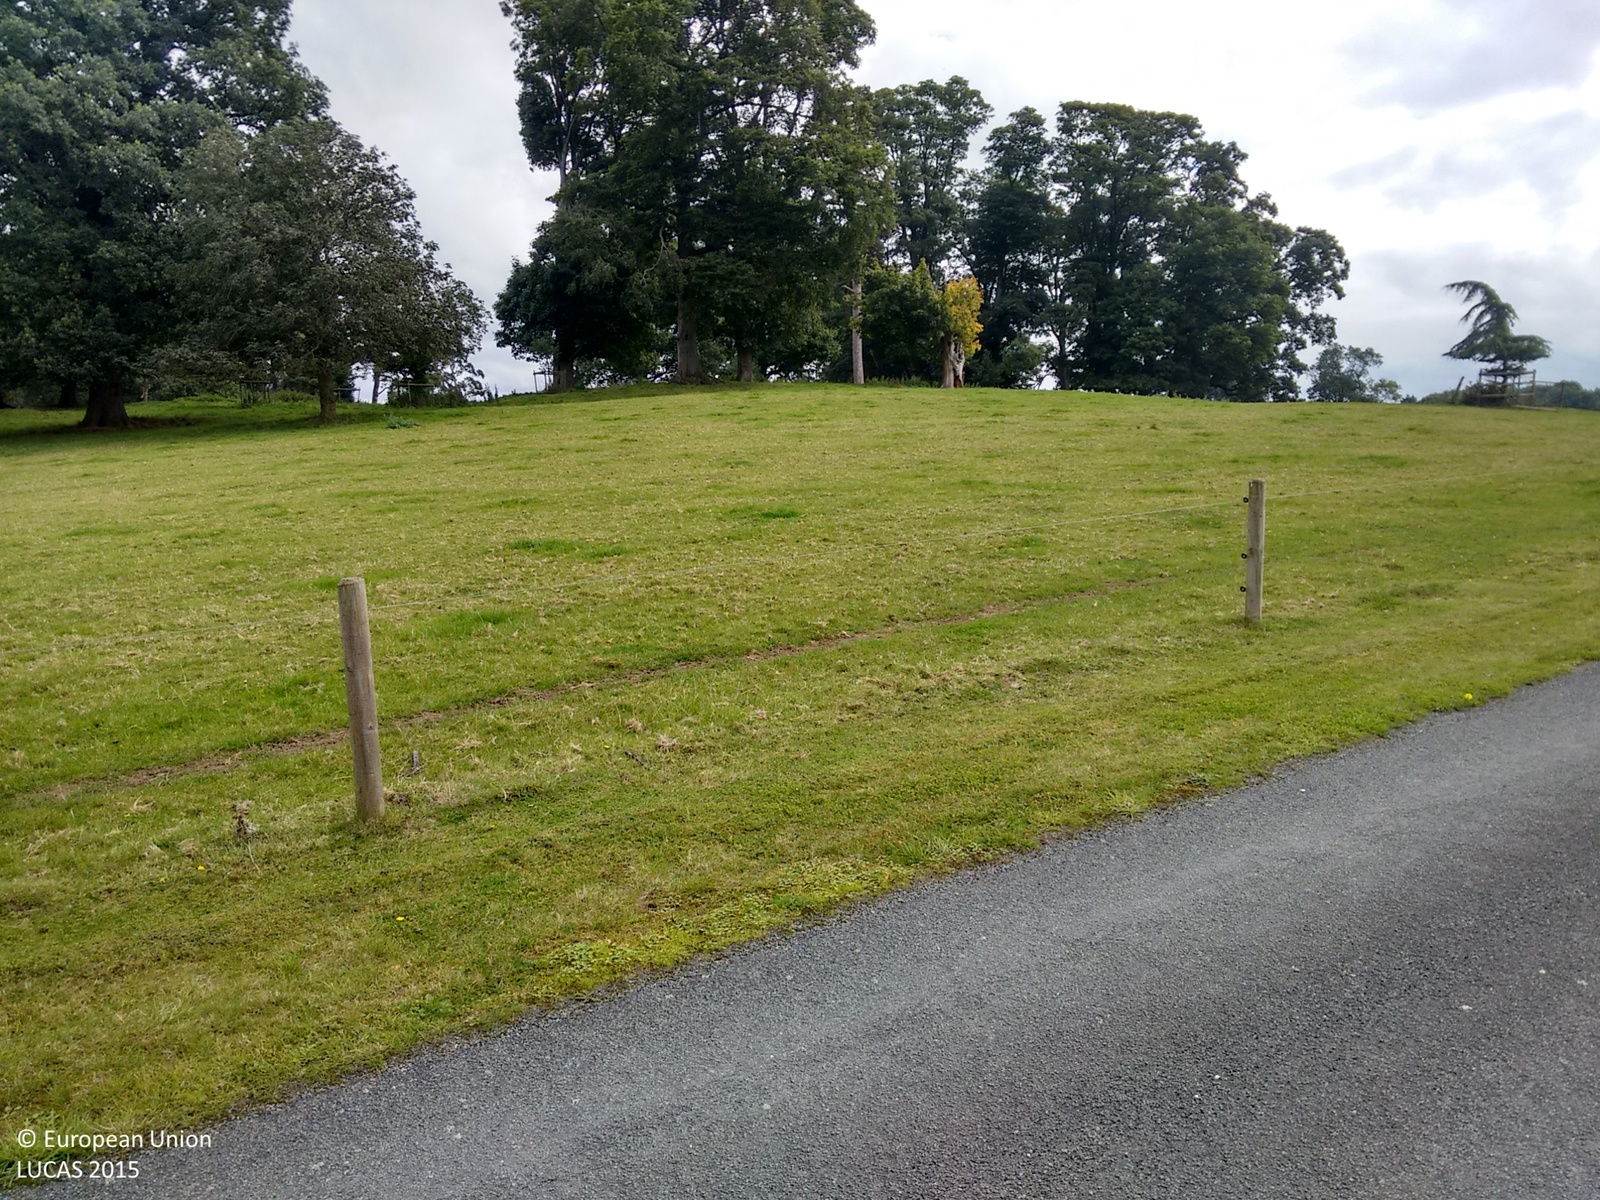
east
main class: Grassland
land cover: Grassland without tree/shrub cover
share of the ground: > 75 %
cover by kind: herbaceous plants 100 %
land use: Agriculture (excluding fallow land and kitchen gardens)
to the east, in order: Grassland without tree/shrub cover; Fences; Grass margins; Paved roads, cycling and walking lanes; Grass margins; Fences; Grassland without tree/shrub cover; Broadleaved woodland; Grassland with sparse tree/shrub cover
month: September
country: GB
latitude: 52.8809
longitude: -2.9876
